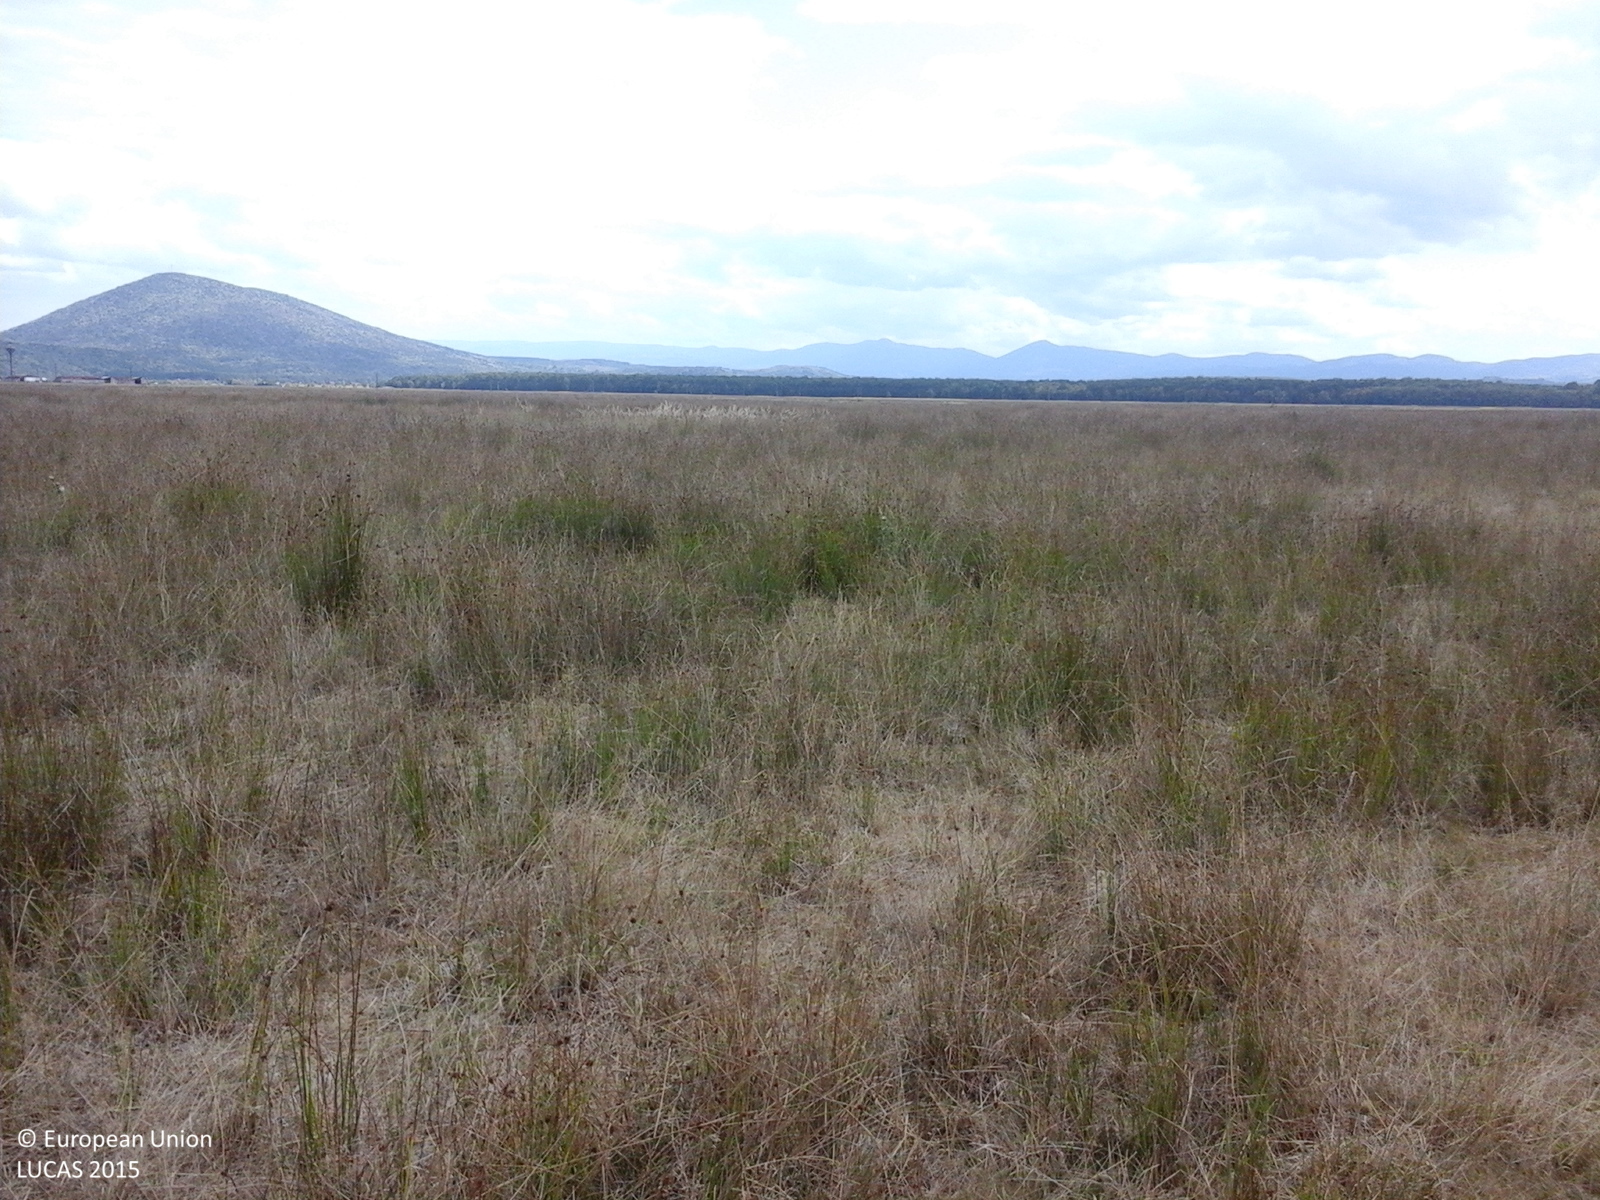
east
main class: Grassland
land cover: Grassland without tree/shrub cover
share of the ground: > 75 %
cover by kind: herbaceous plants 100 %
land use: Agriculture (excluding fallow land and kitchen gardens)
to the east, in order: Grassland without tree/shrub cover; Ditches and canals; Grassland without tree/shrub cover
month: September
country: RO
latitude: 47.8827
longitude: 23.1887
